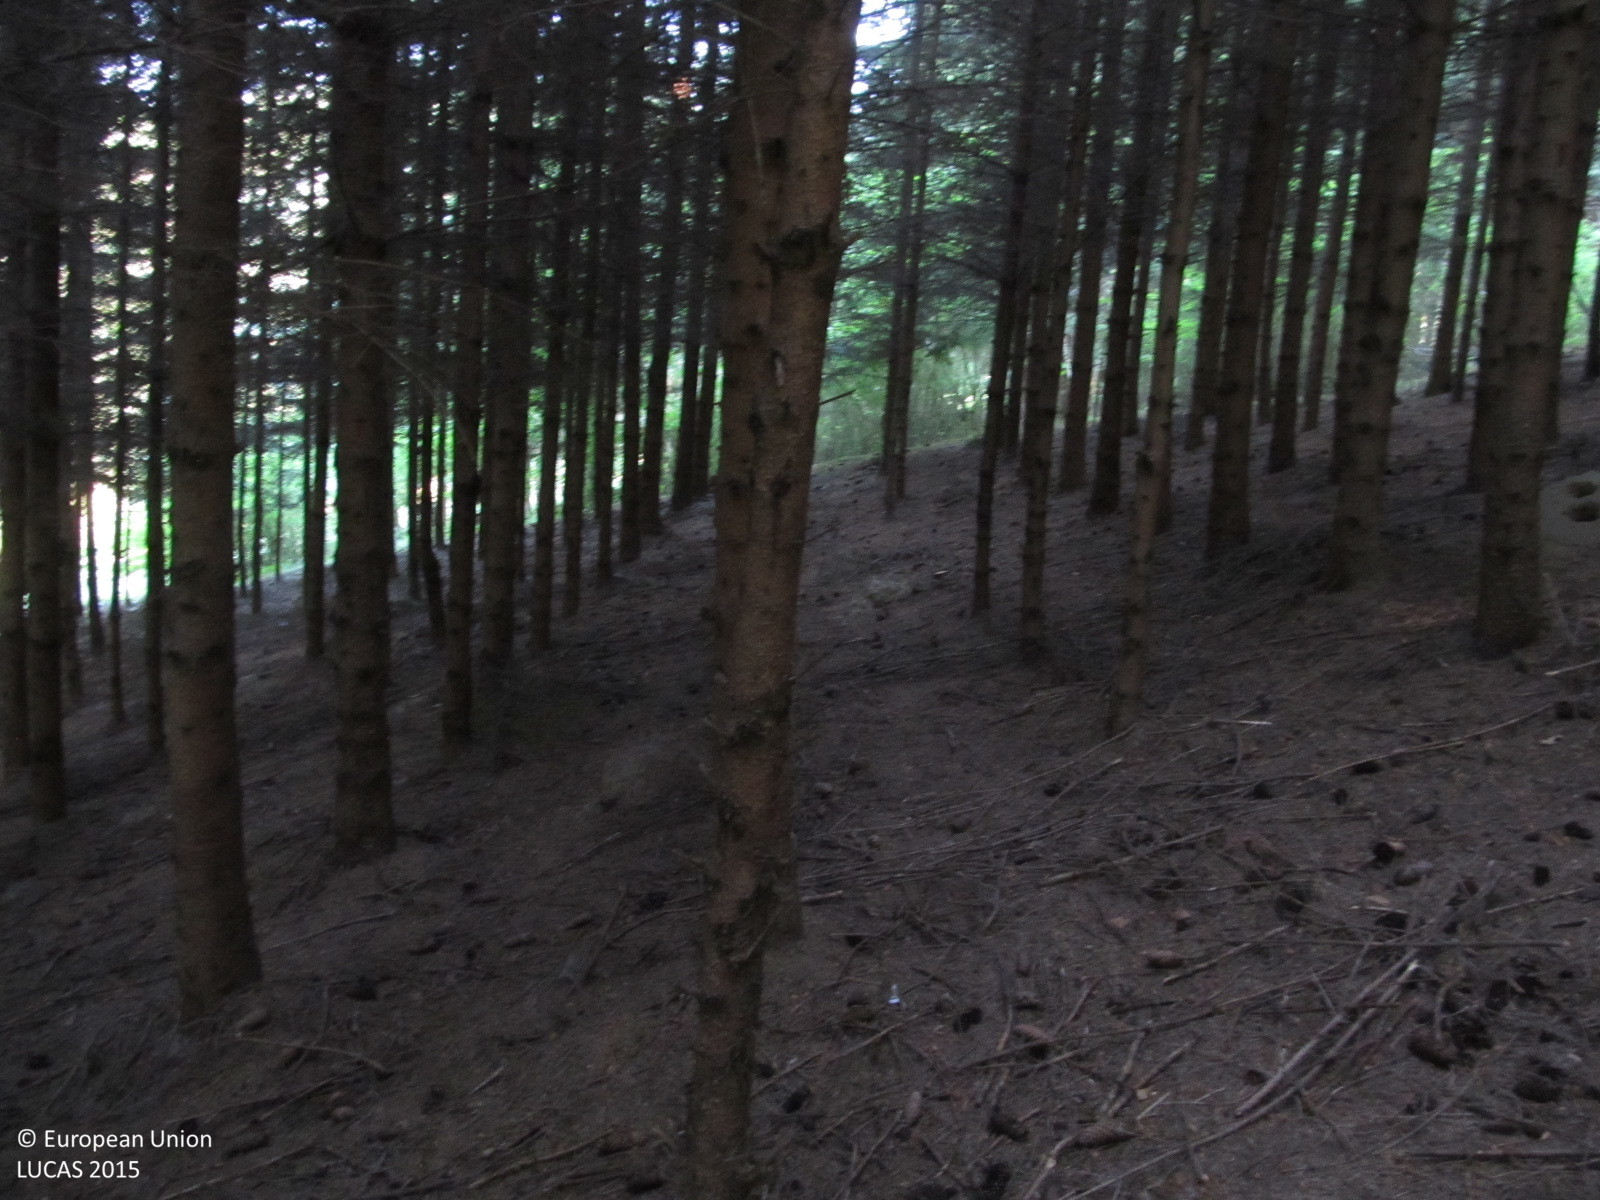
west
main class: Woodland
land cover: Spruce dominated coniferous woodland
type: hemiboreal forest and nemoral coniferous forest and mixed broadleaved-coniferous forest
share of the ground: > 75 %
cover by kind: coniferous forest trees 85 %, unconsolidated bare surface 15 %
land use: Forestry
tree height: > 5 m
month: June
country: AT
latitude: 48.5417
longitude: 15.4070
